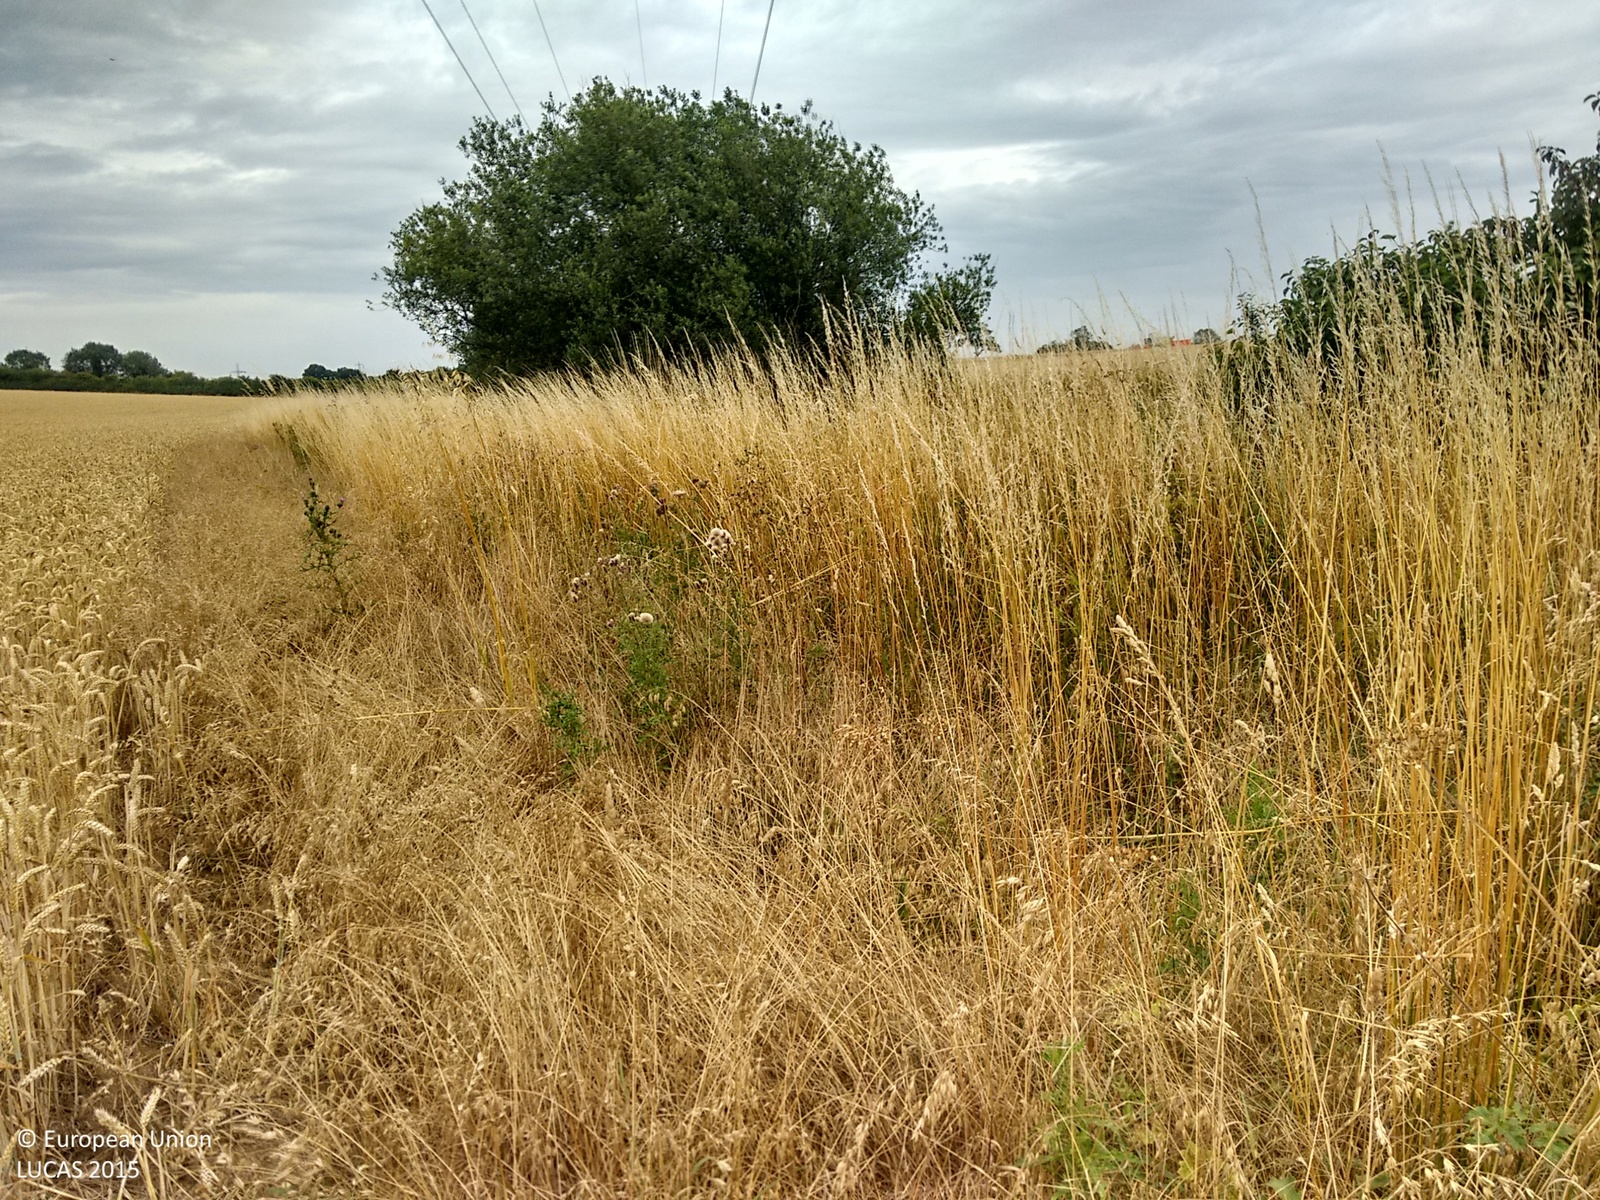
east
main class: Cropland
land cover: Common wheat
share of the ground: > 75 %
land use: Agriculture (excluding fallow land and kitchen gardens)
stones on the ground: 10 - 25 %
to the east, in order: Common wheat; Grass margins; Shrubland with sparse tree cover; Inland fresh running water; Shrubland with sparse tree cover; Grass margins; Common wheat; Electric lines; Common wheat
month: August
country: GB
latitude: 51.9950
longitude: 0.4909
